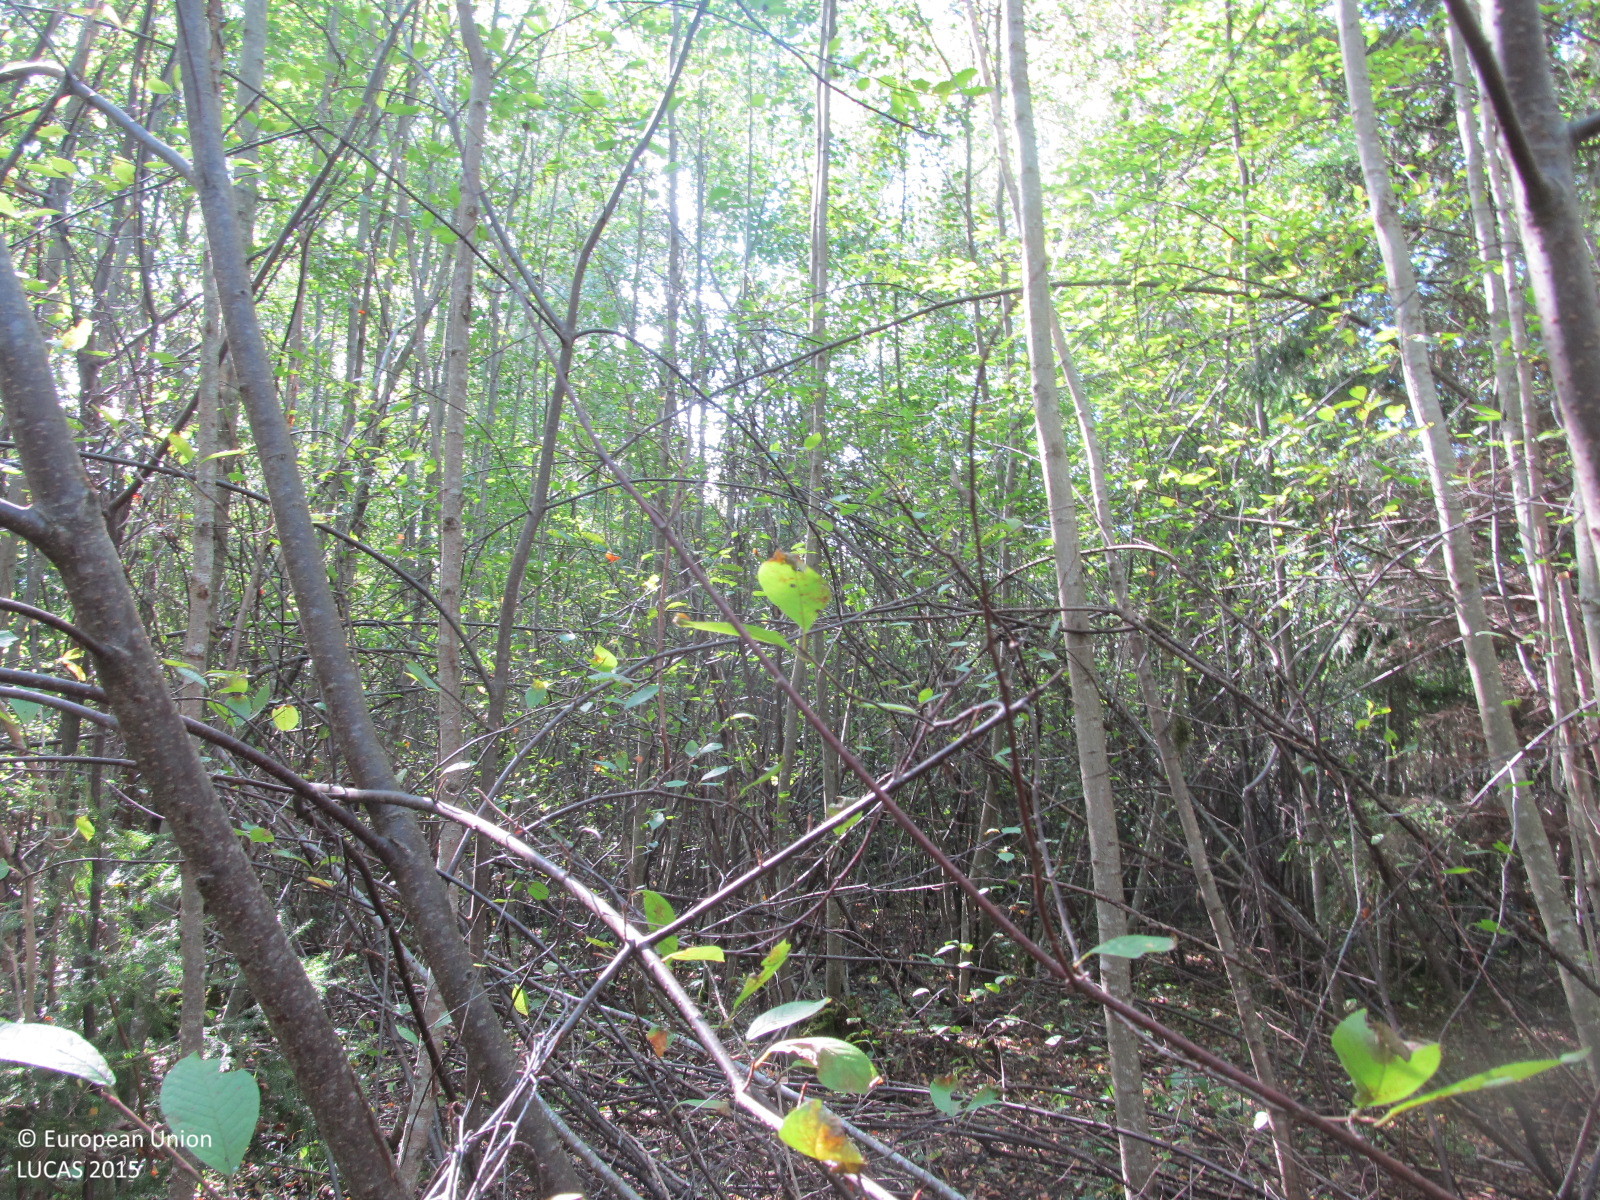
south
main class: Woodland
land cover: Broadleaved woodland
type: non-riverine alder, birch or aspen forest
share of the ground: > 75 %
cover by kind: broadleaved forest trees 85 %, shrubs 5 %, herbaceous plants 5 %, unconsolidated bare surface 5 %
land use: Forestry
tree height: > 5 m
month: September
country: LT
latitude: 56.0868
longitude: 23.3648
